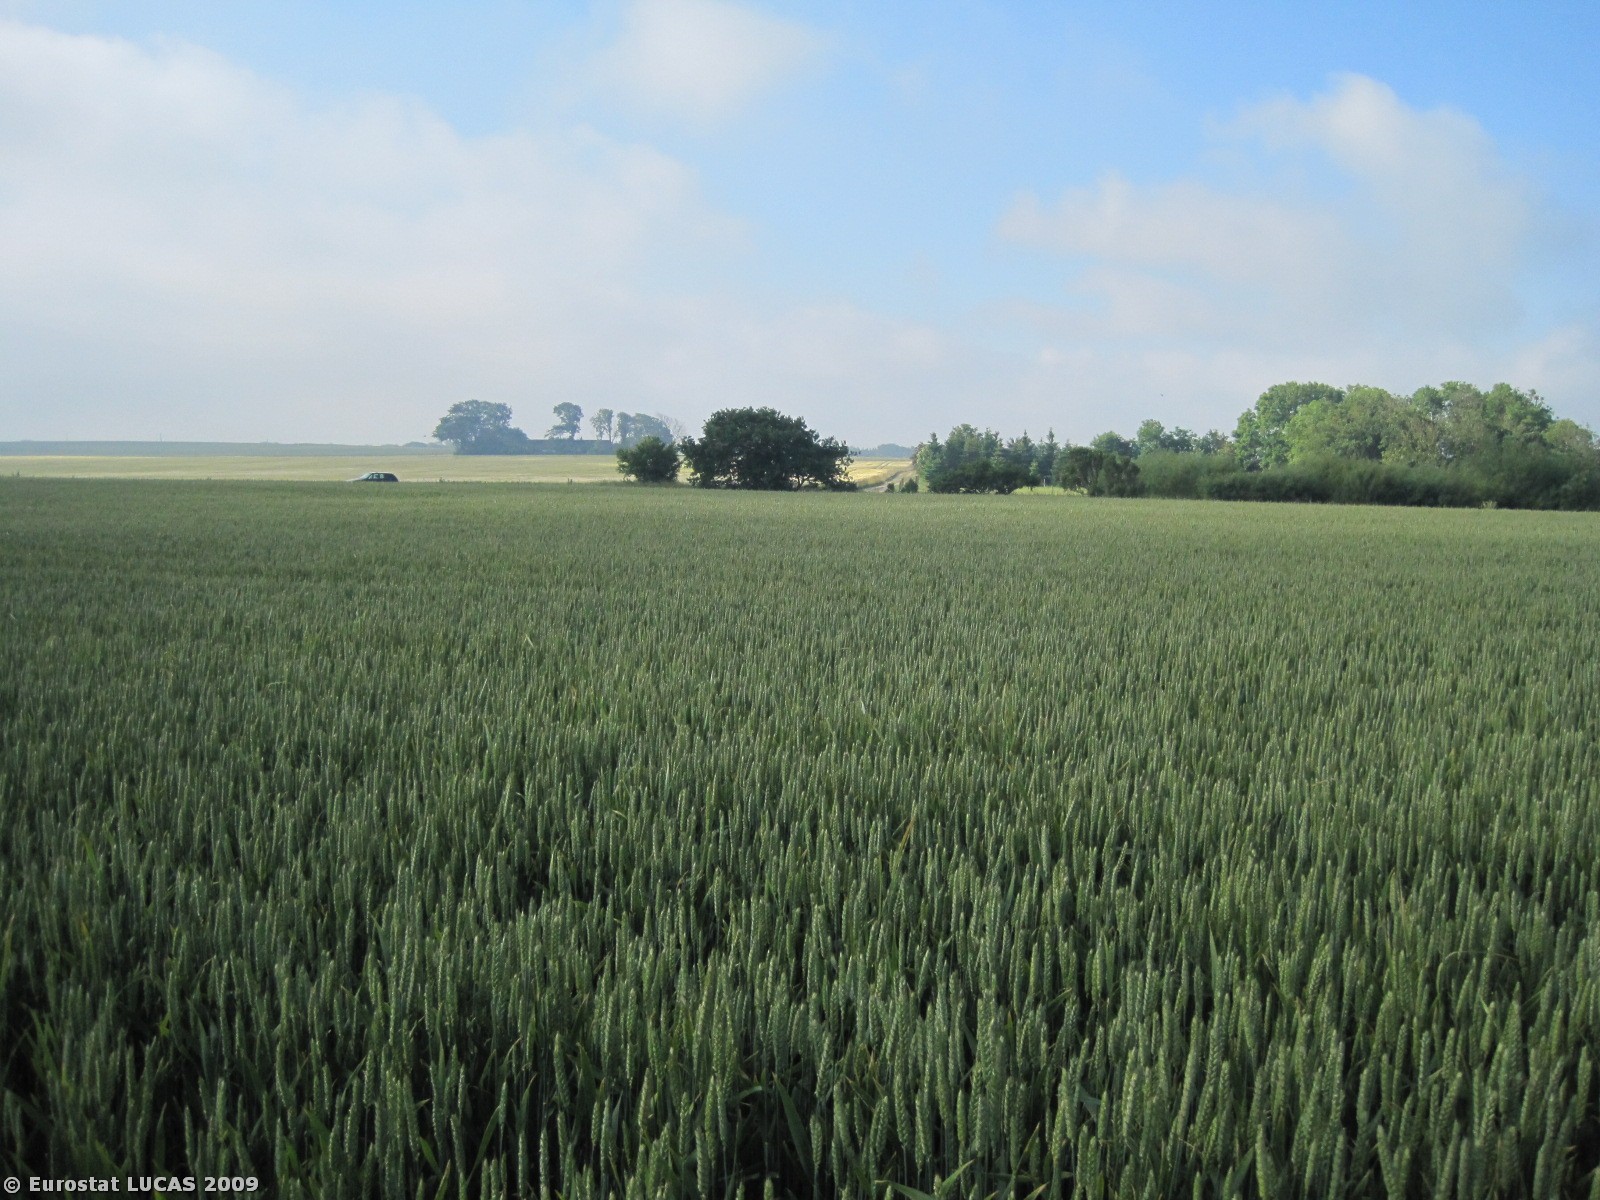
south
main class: Cropland
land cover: Common wheat
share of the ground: > 75 %
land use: Agriculture (excluding fallow land and kitchen gardens)
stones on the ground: 10 - 25 %
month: June
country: DK
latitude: 56.7589
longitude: 8.9709
